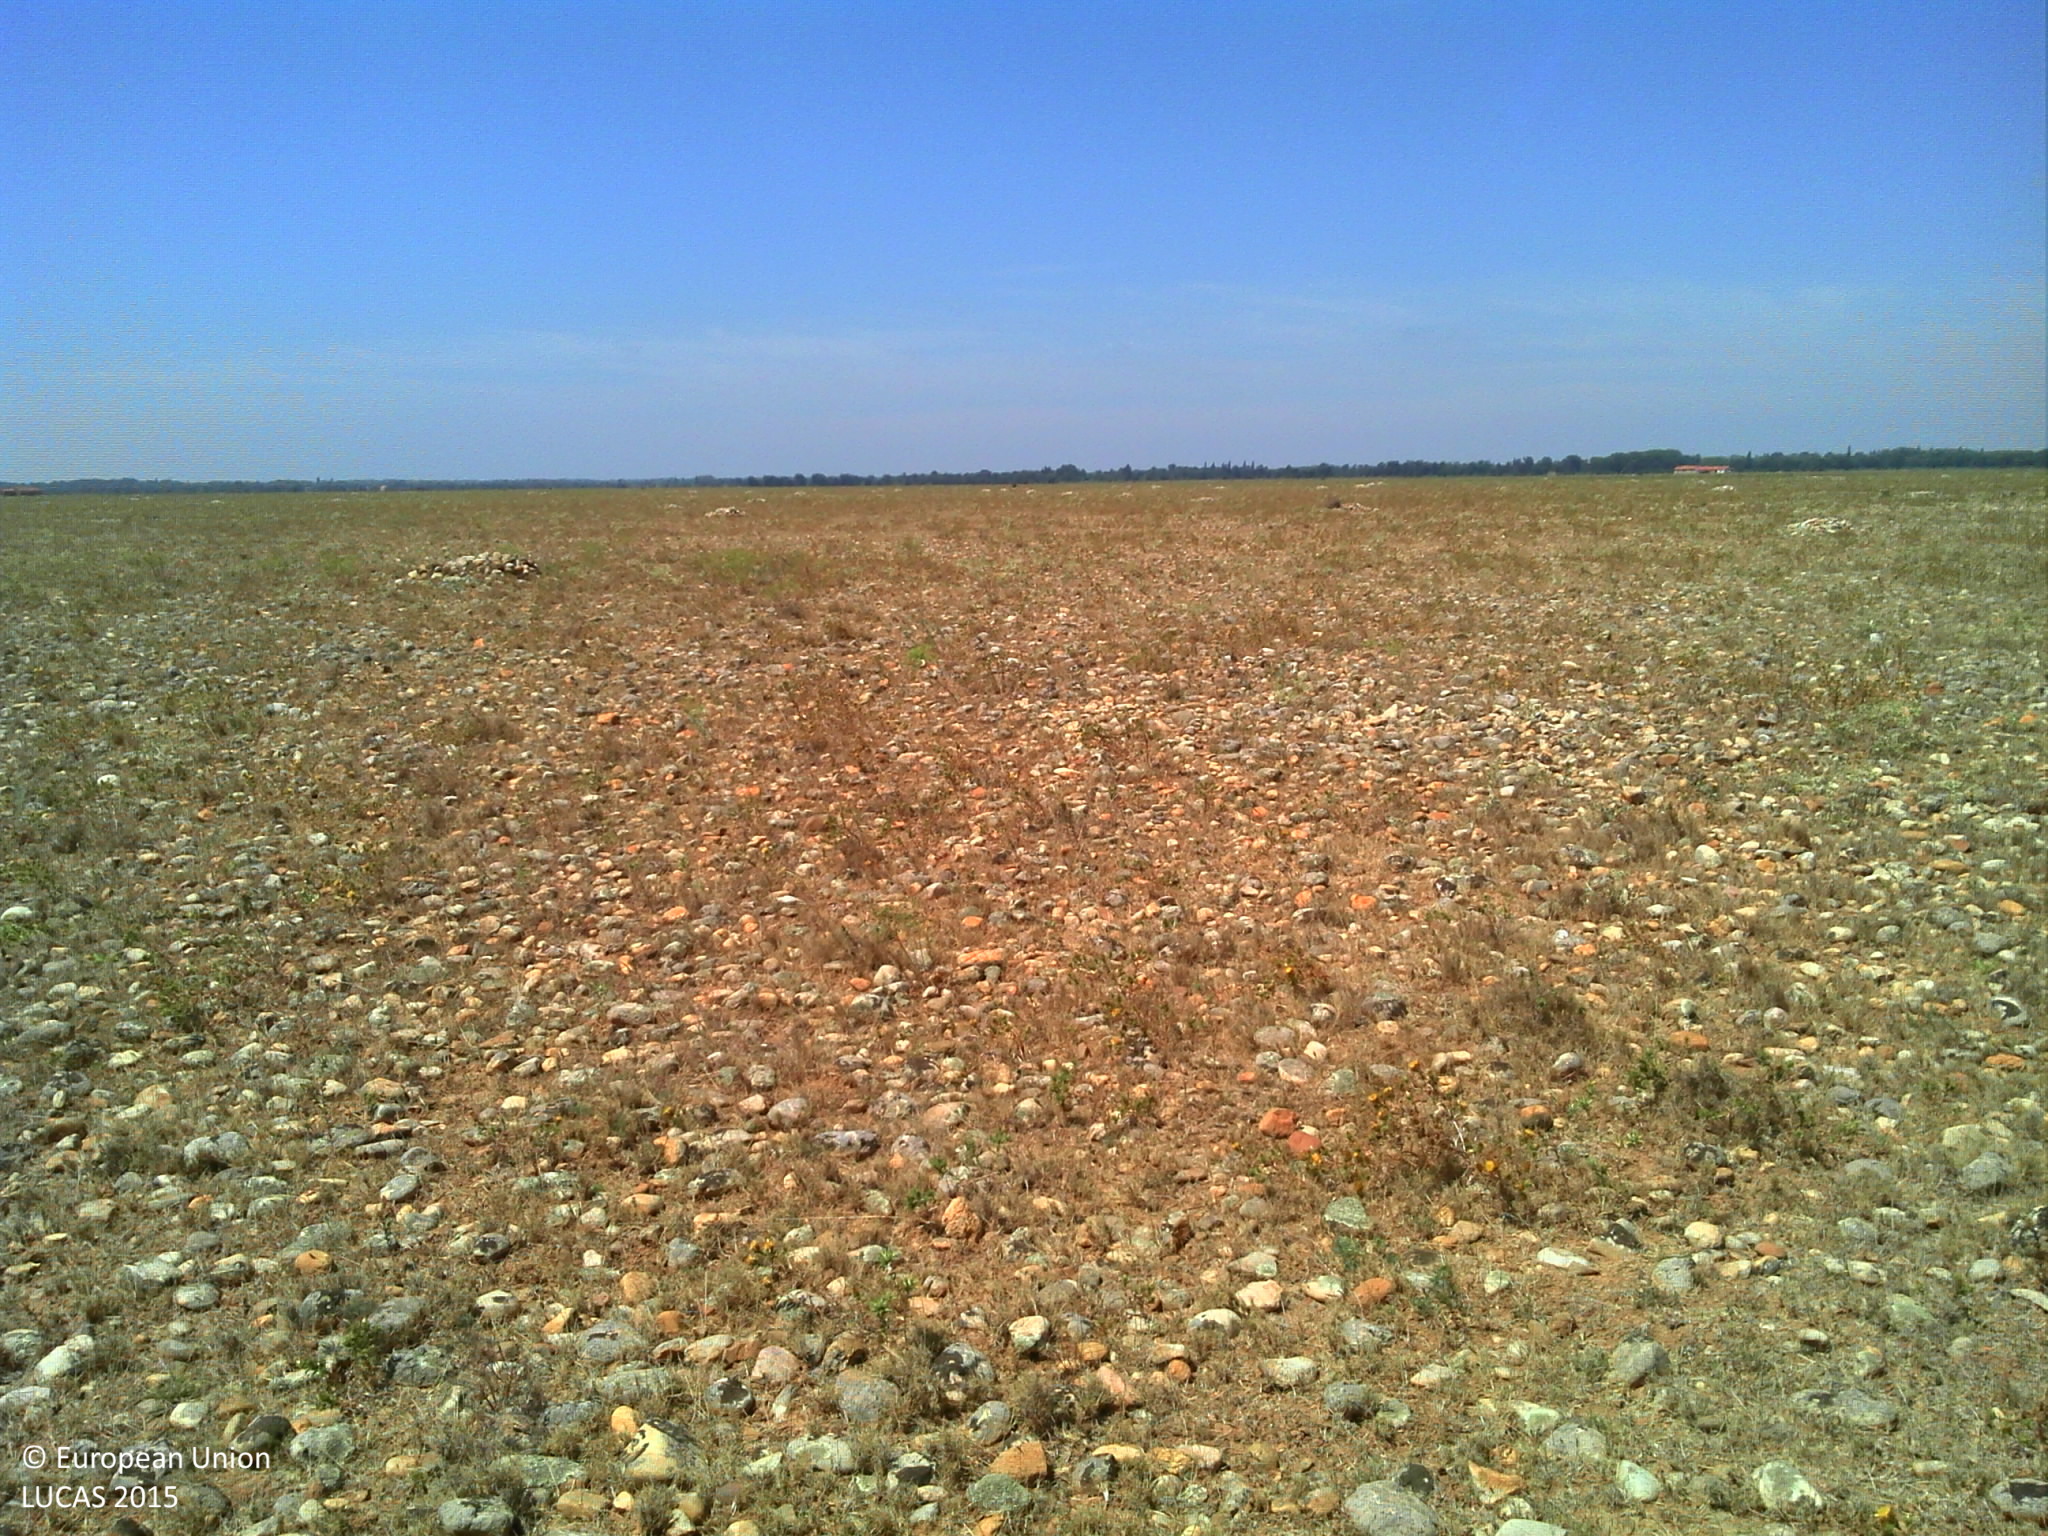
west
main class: Grassland
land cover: Spontaneously vegetated surfaces
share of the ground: 25 - 50 %
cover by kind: unconsolidated bare surface 45 %, herbaceous plants 30 %, consolidated bare surface 20 %, shrubs 5 %
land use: Agriculture (excluding fallow land and kitchen gardens)
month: July
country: FR
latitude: 43.5538
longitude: 4.8480
